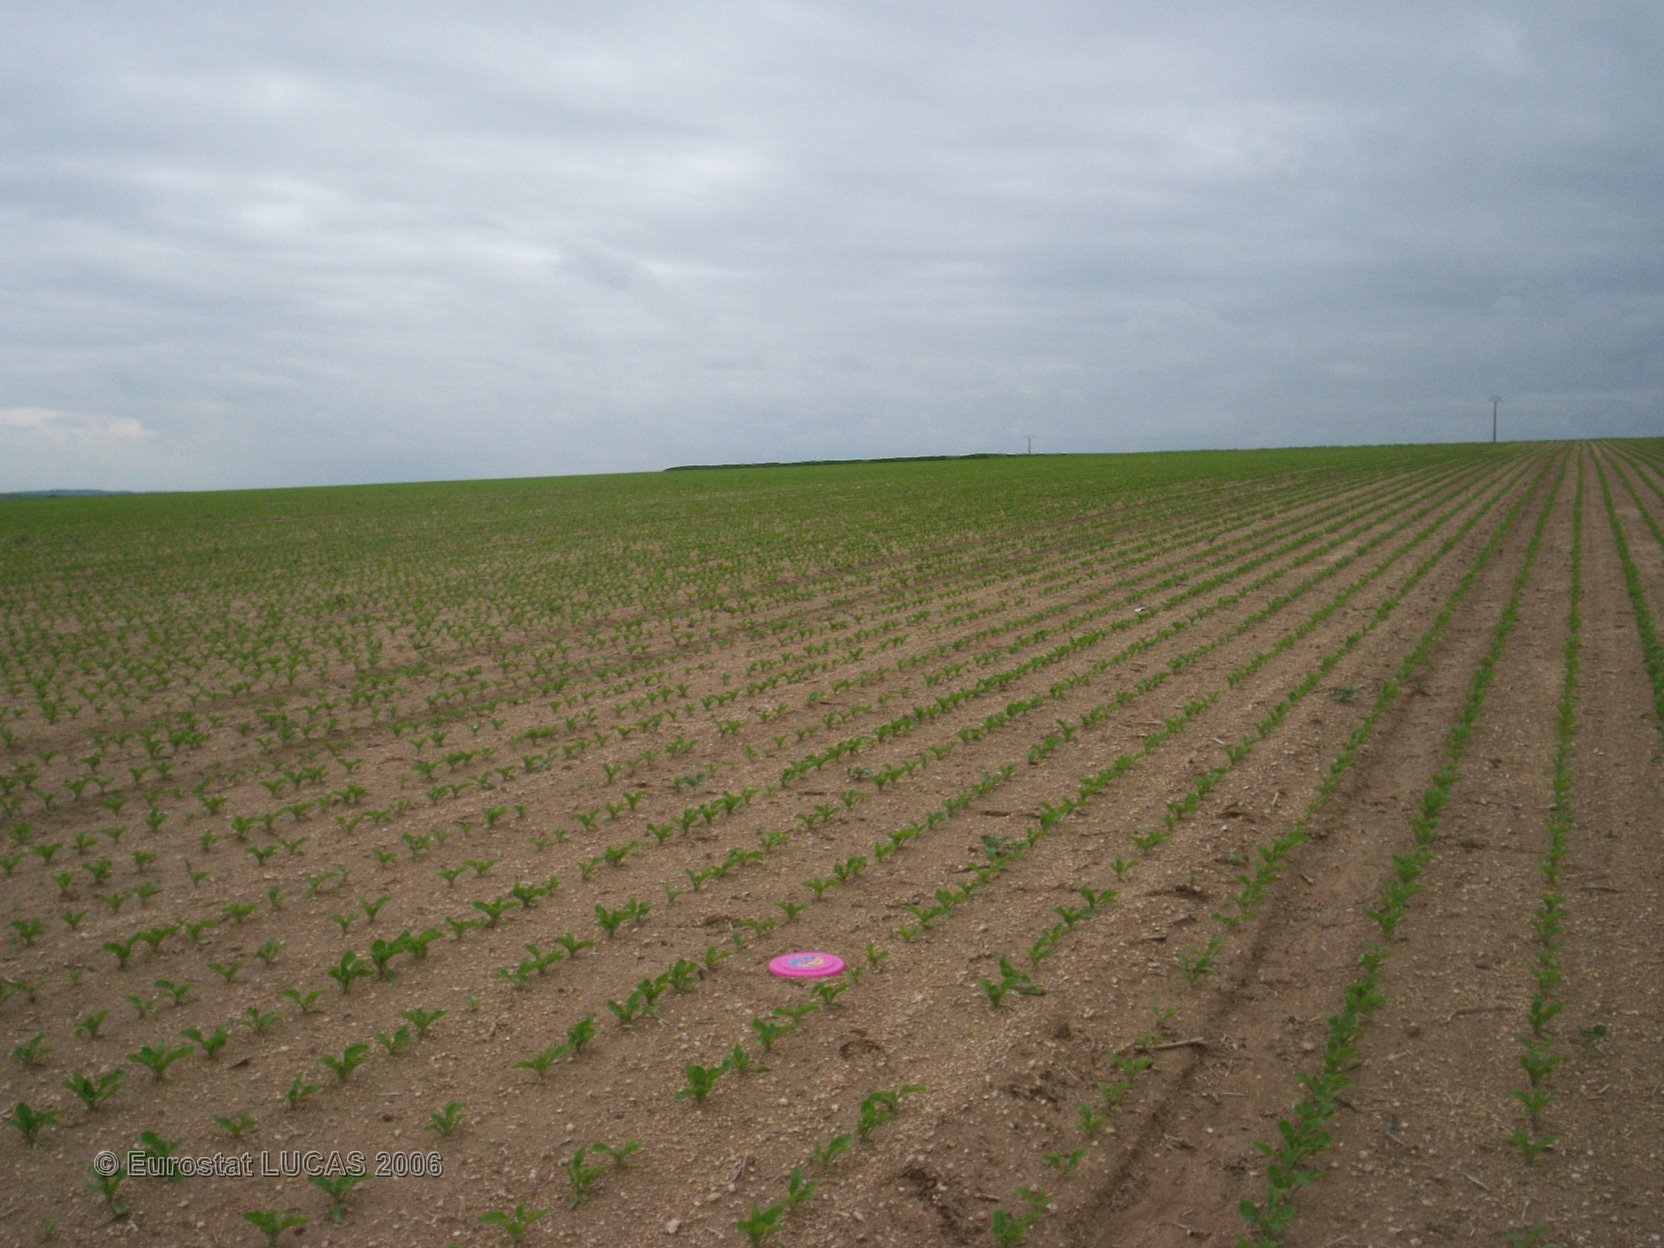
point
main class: Cropland
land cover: Sugar beet
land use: Agriculture (excluding fallow land and kitchen gardens)
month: May
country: FR
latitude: 49.4122
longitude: 4.3309
